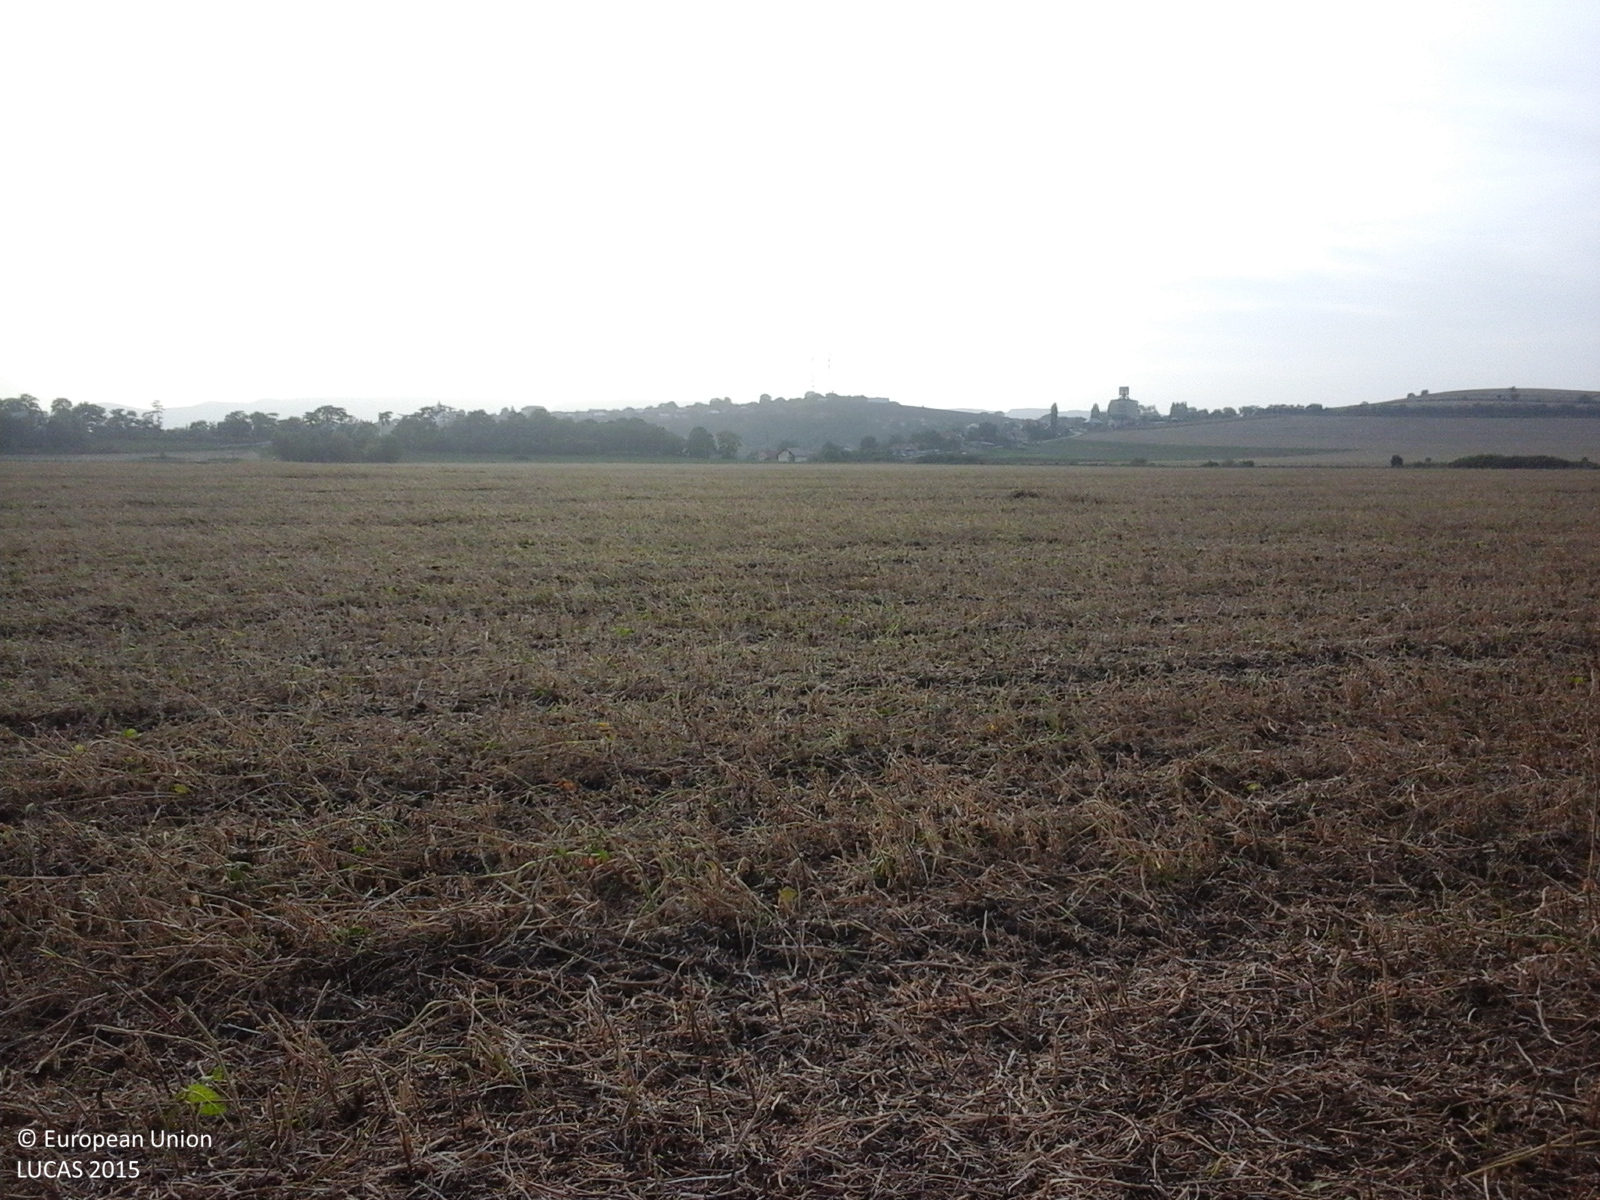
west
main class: Cropland
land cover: Soya
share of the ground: 50 - 75 %
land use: Agriculture (excluding fallow land and kitchen gardens)
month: September
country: RO
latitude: 46.5817
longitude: 23.8154
